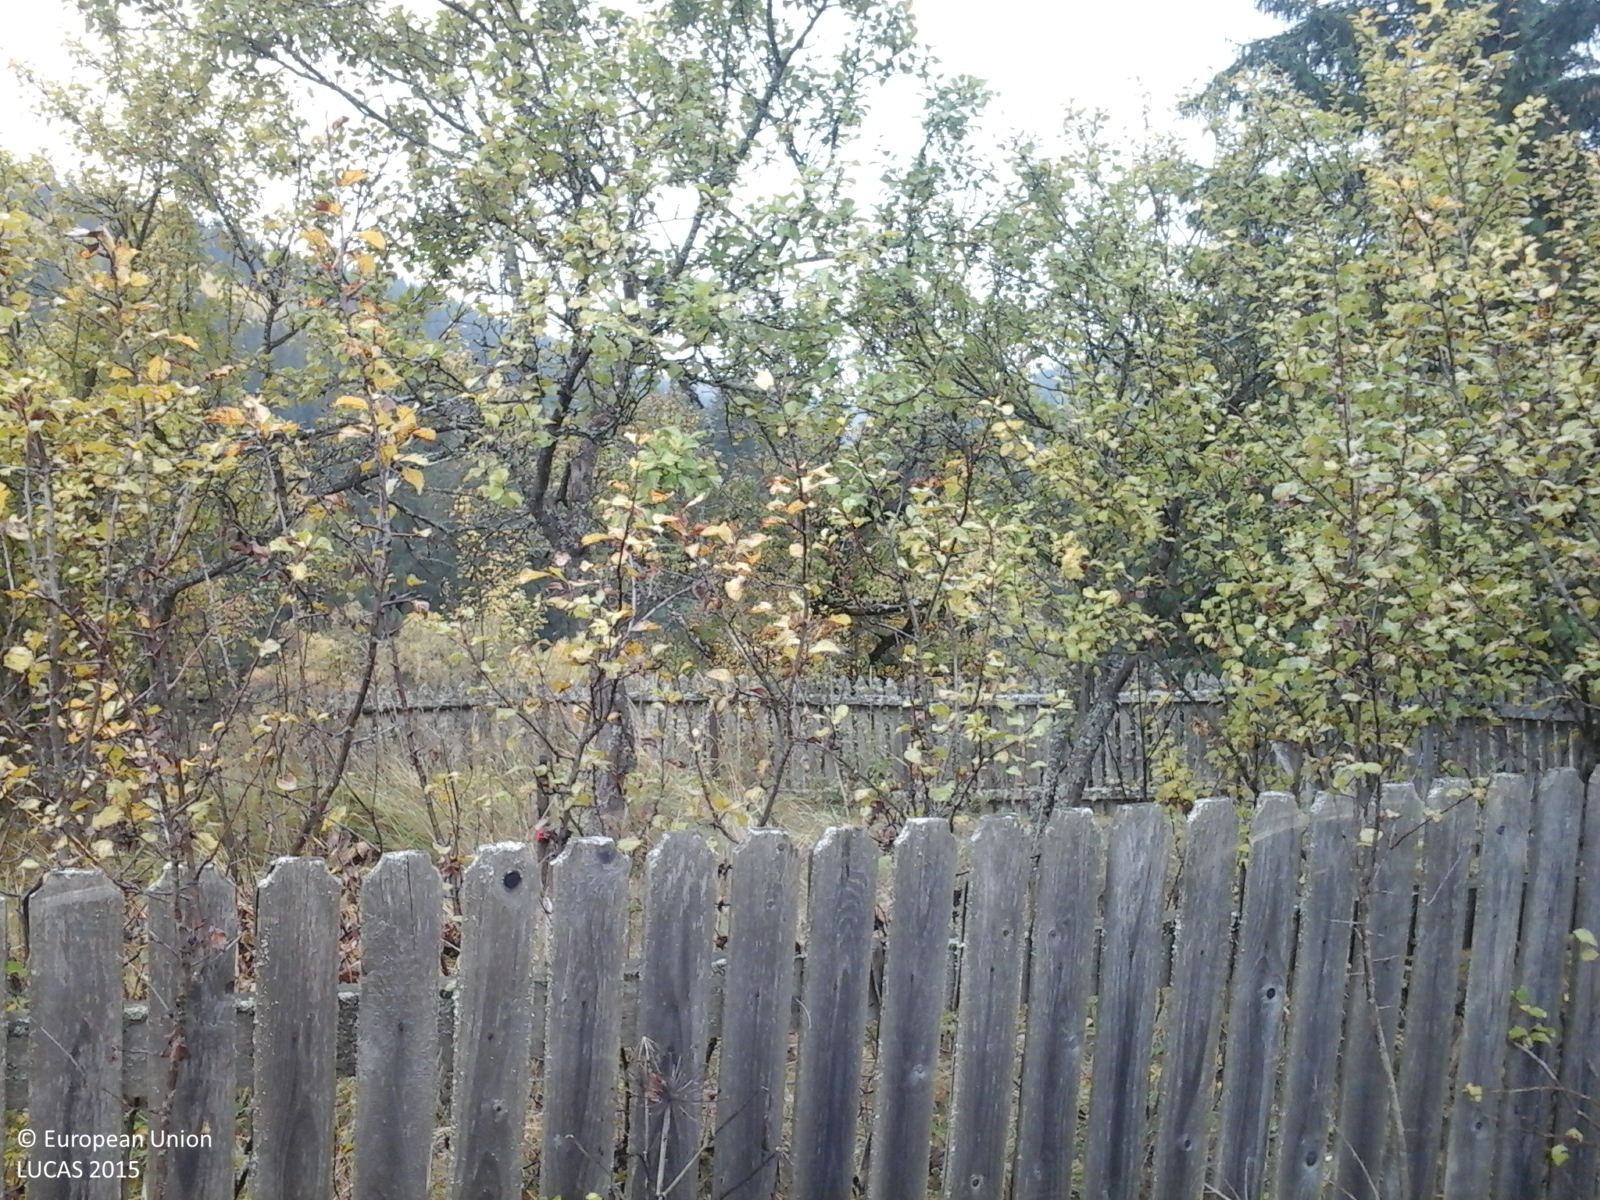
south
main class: Grassland
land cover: Grassland without tree/shrub cover
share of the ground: > 75 %
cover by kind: herbaceous plants 100 %
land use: Agriculture (excluding fallow land and kitchen gardens)
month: October
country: RO
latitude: 46.9059
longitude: 25.3232
